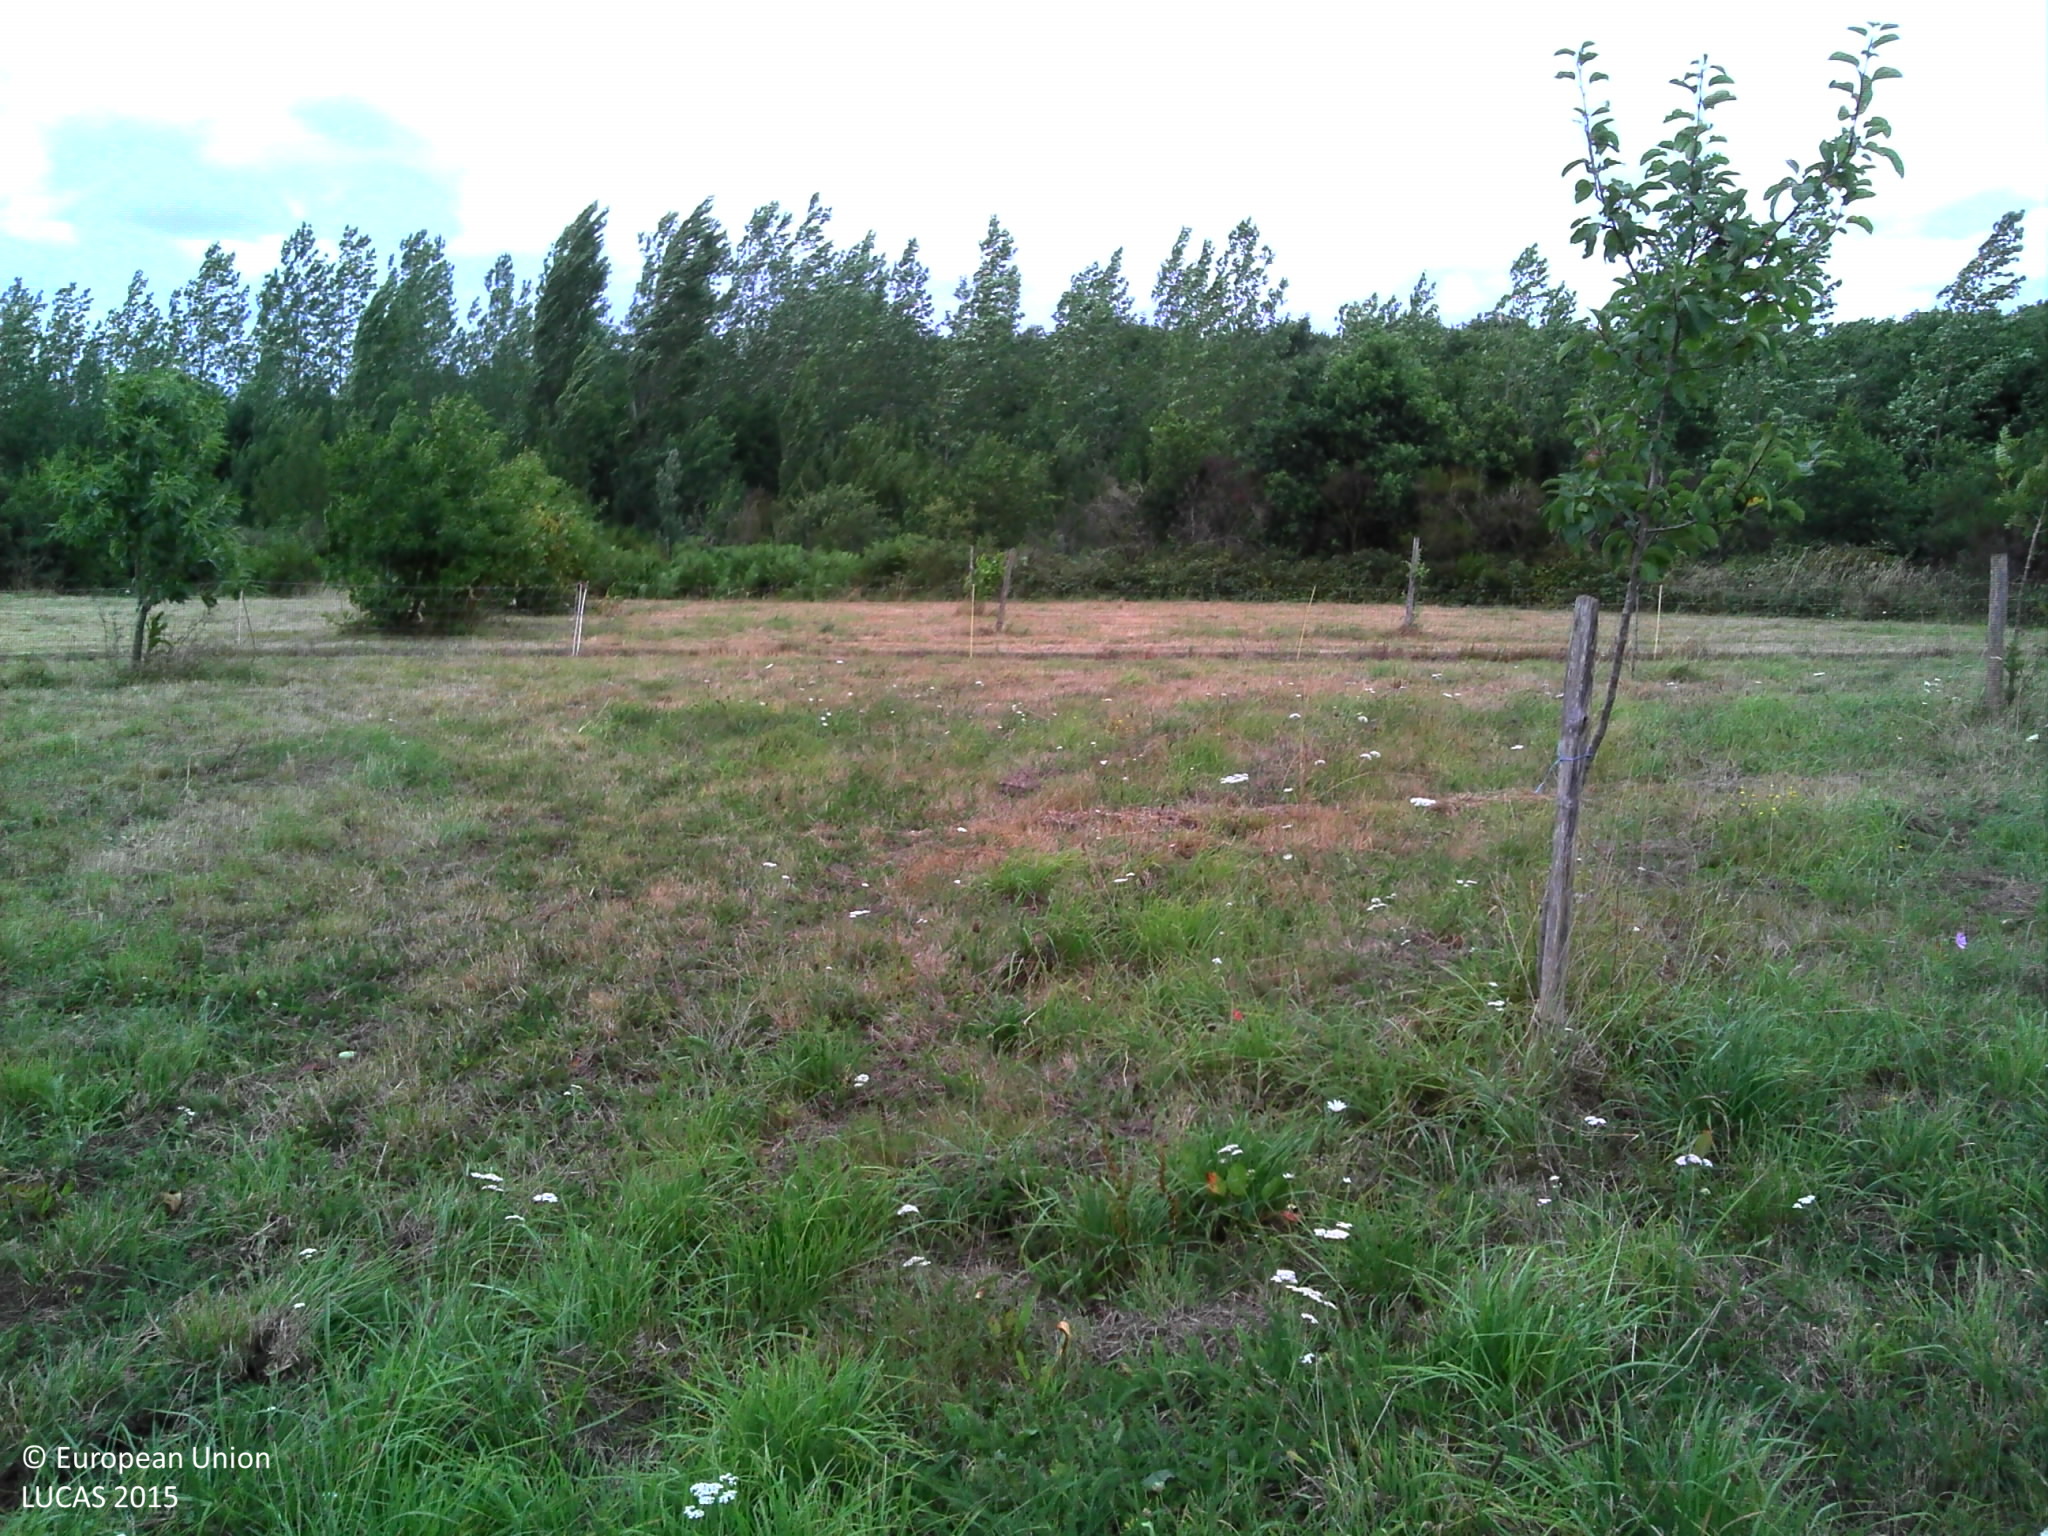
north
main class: Grassland
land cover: Grassland with sparse tree/shrub cover
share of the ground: > 75 %
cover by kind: herbaceous plants 95 %, broadleaved forest trees 5 %
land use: Agriculture (excluding fallow land and kitchen gardens)
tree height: < 5 m
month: July
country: FR
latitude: 47.3939
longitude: -1.9052
